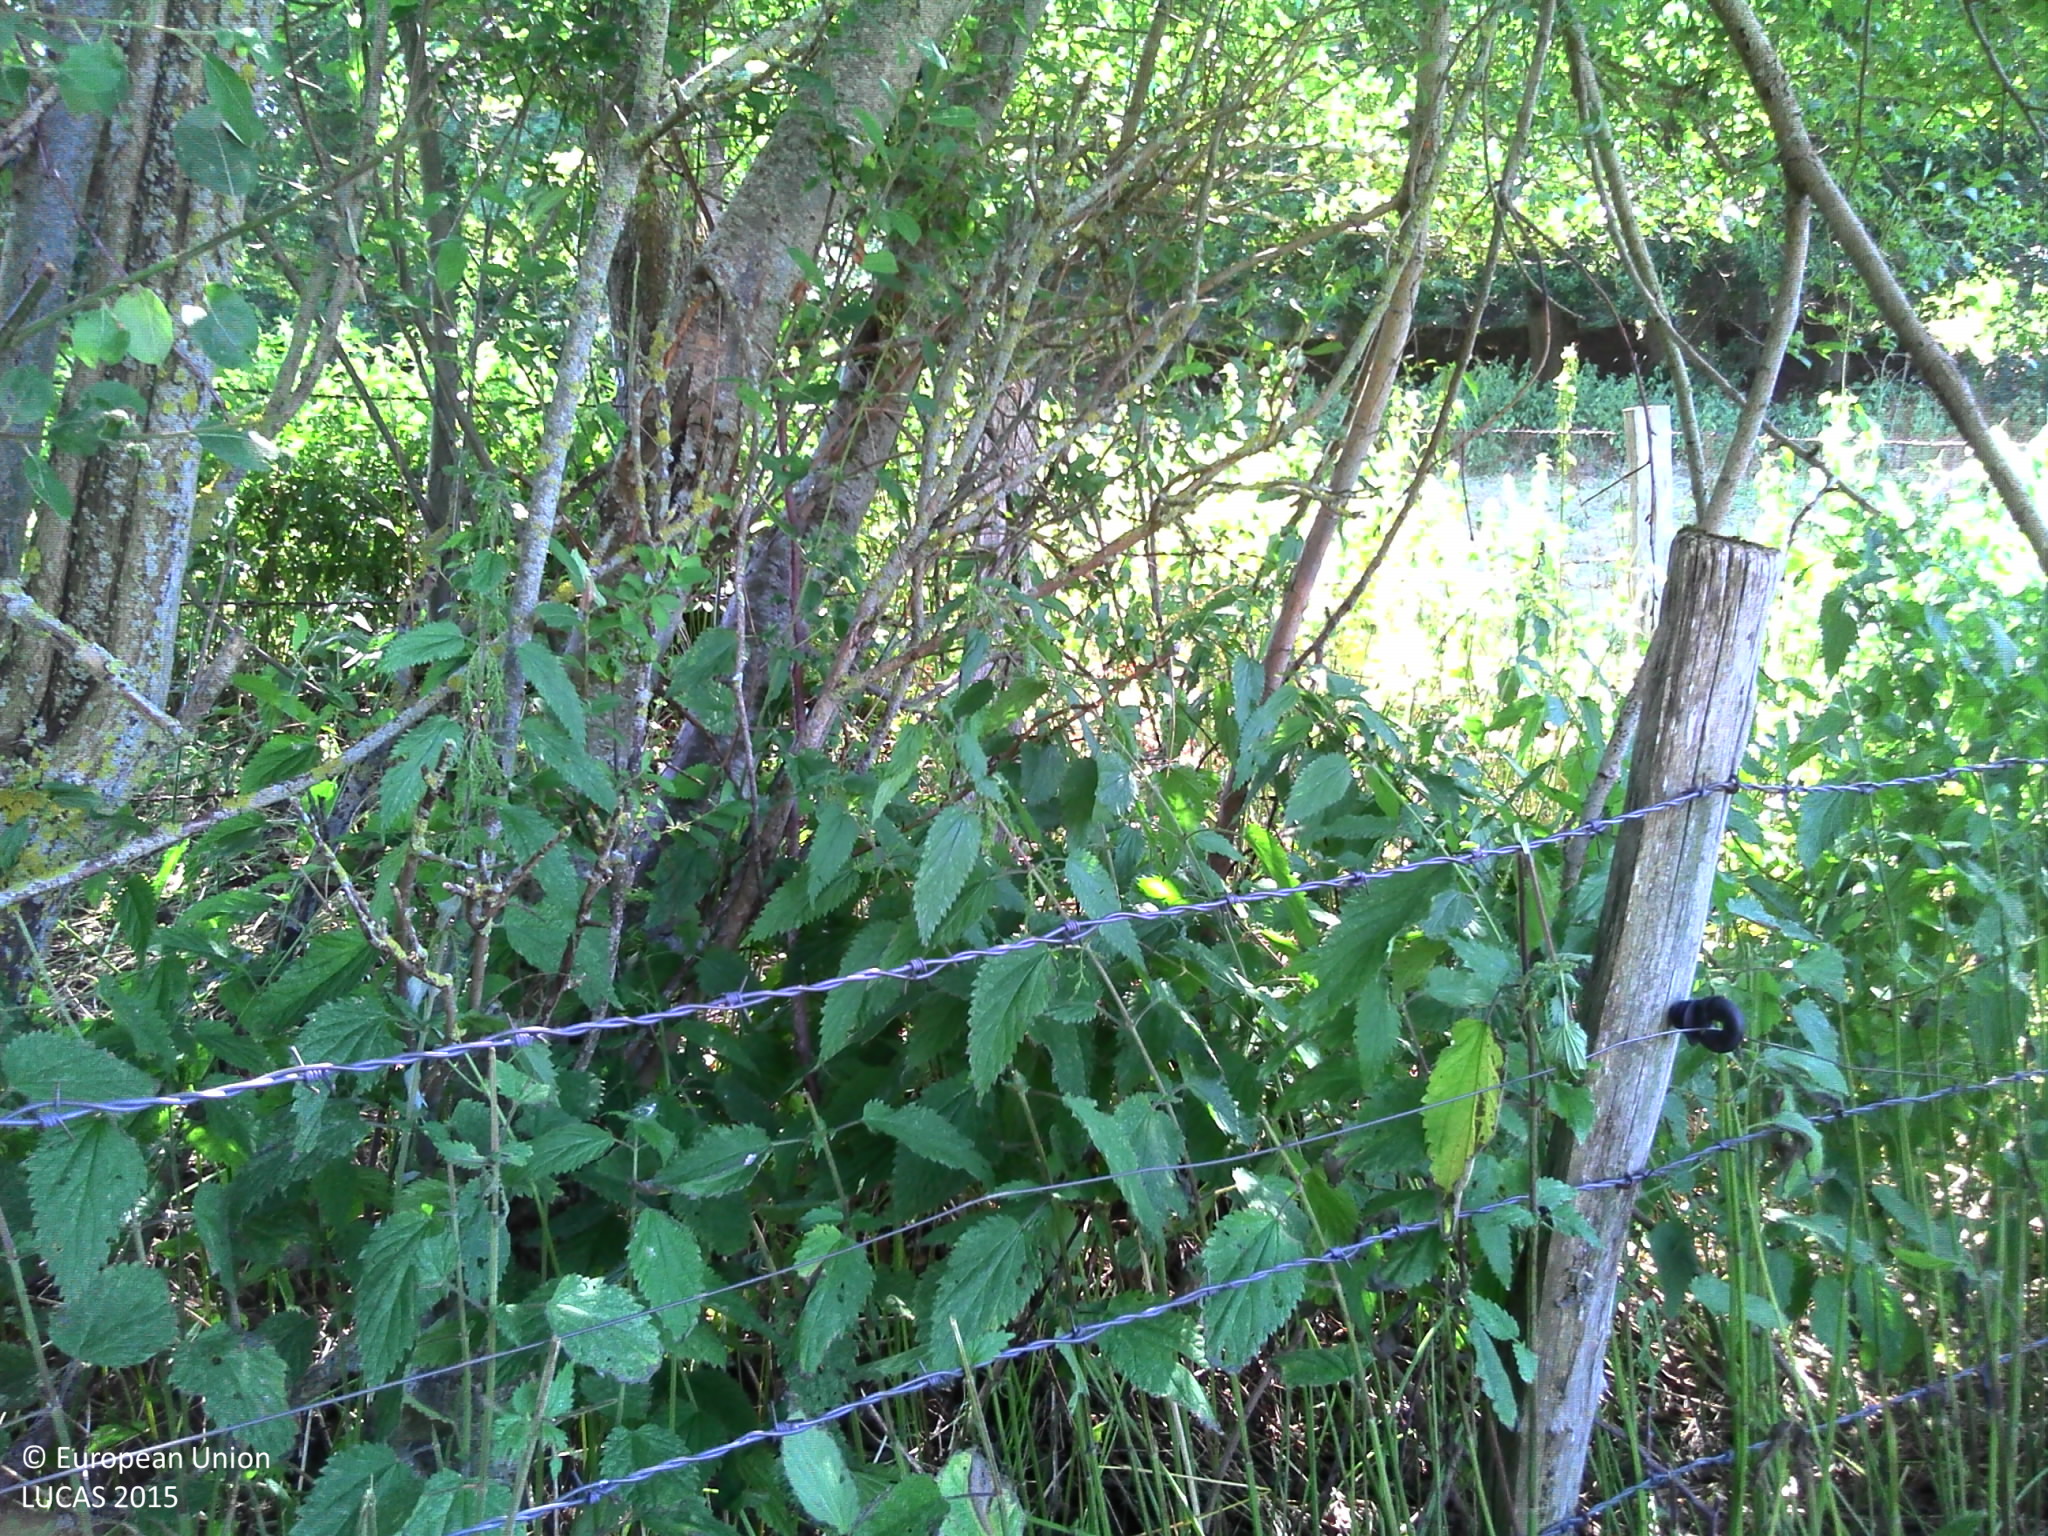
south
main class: Woodland
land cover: Broadleaved woodland
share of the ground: > 75 %
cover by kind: herbaceous plants 80 %, broadleaved forest trees 20 %
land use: Agriculture (excluding fallow land and kitchen gardens)
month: August
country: FR
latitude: 45.6794
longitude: 2.8739
